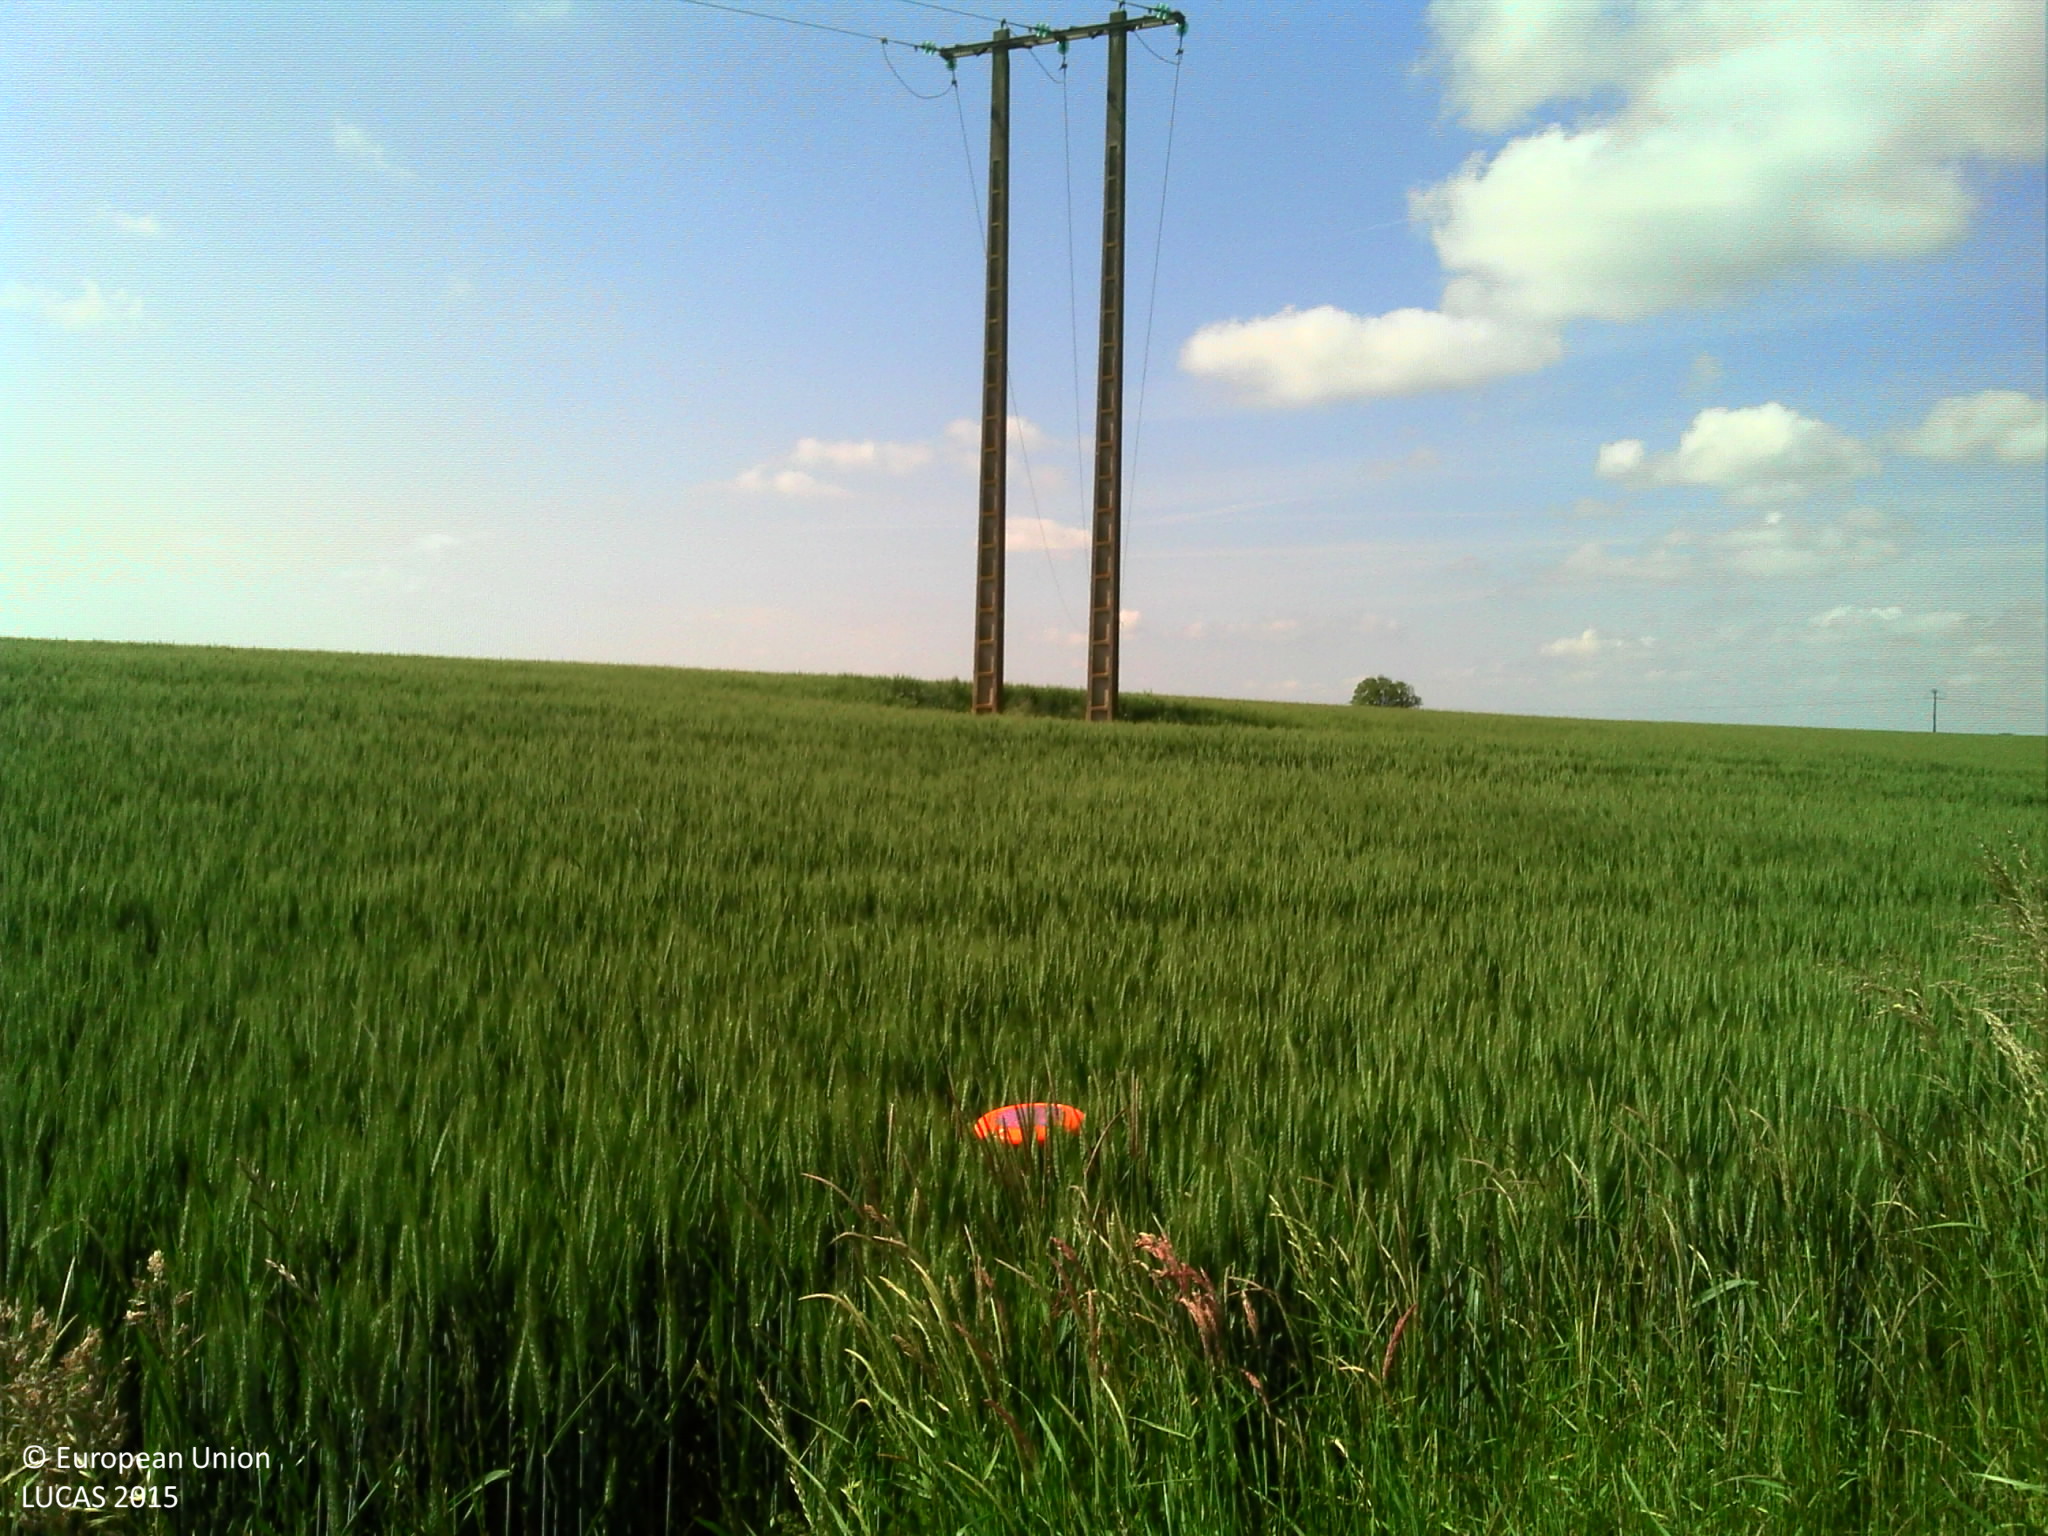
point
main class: Cropland
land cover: Common wheat
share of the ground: > 75 %
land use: Agriculture (excluding fallow land and kitchen gardens)
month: May
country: FR
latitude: 47.4346
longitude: 5.2141
